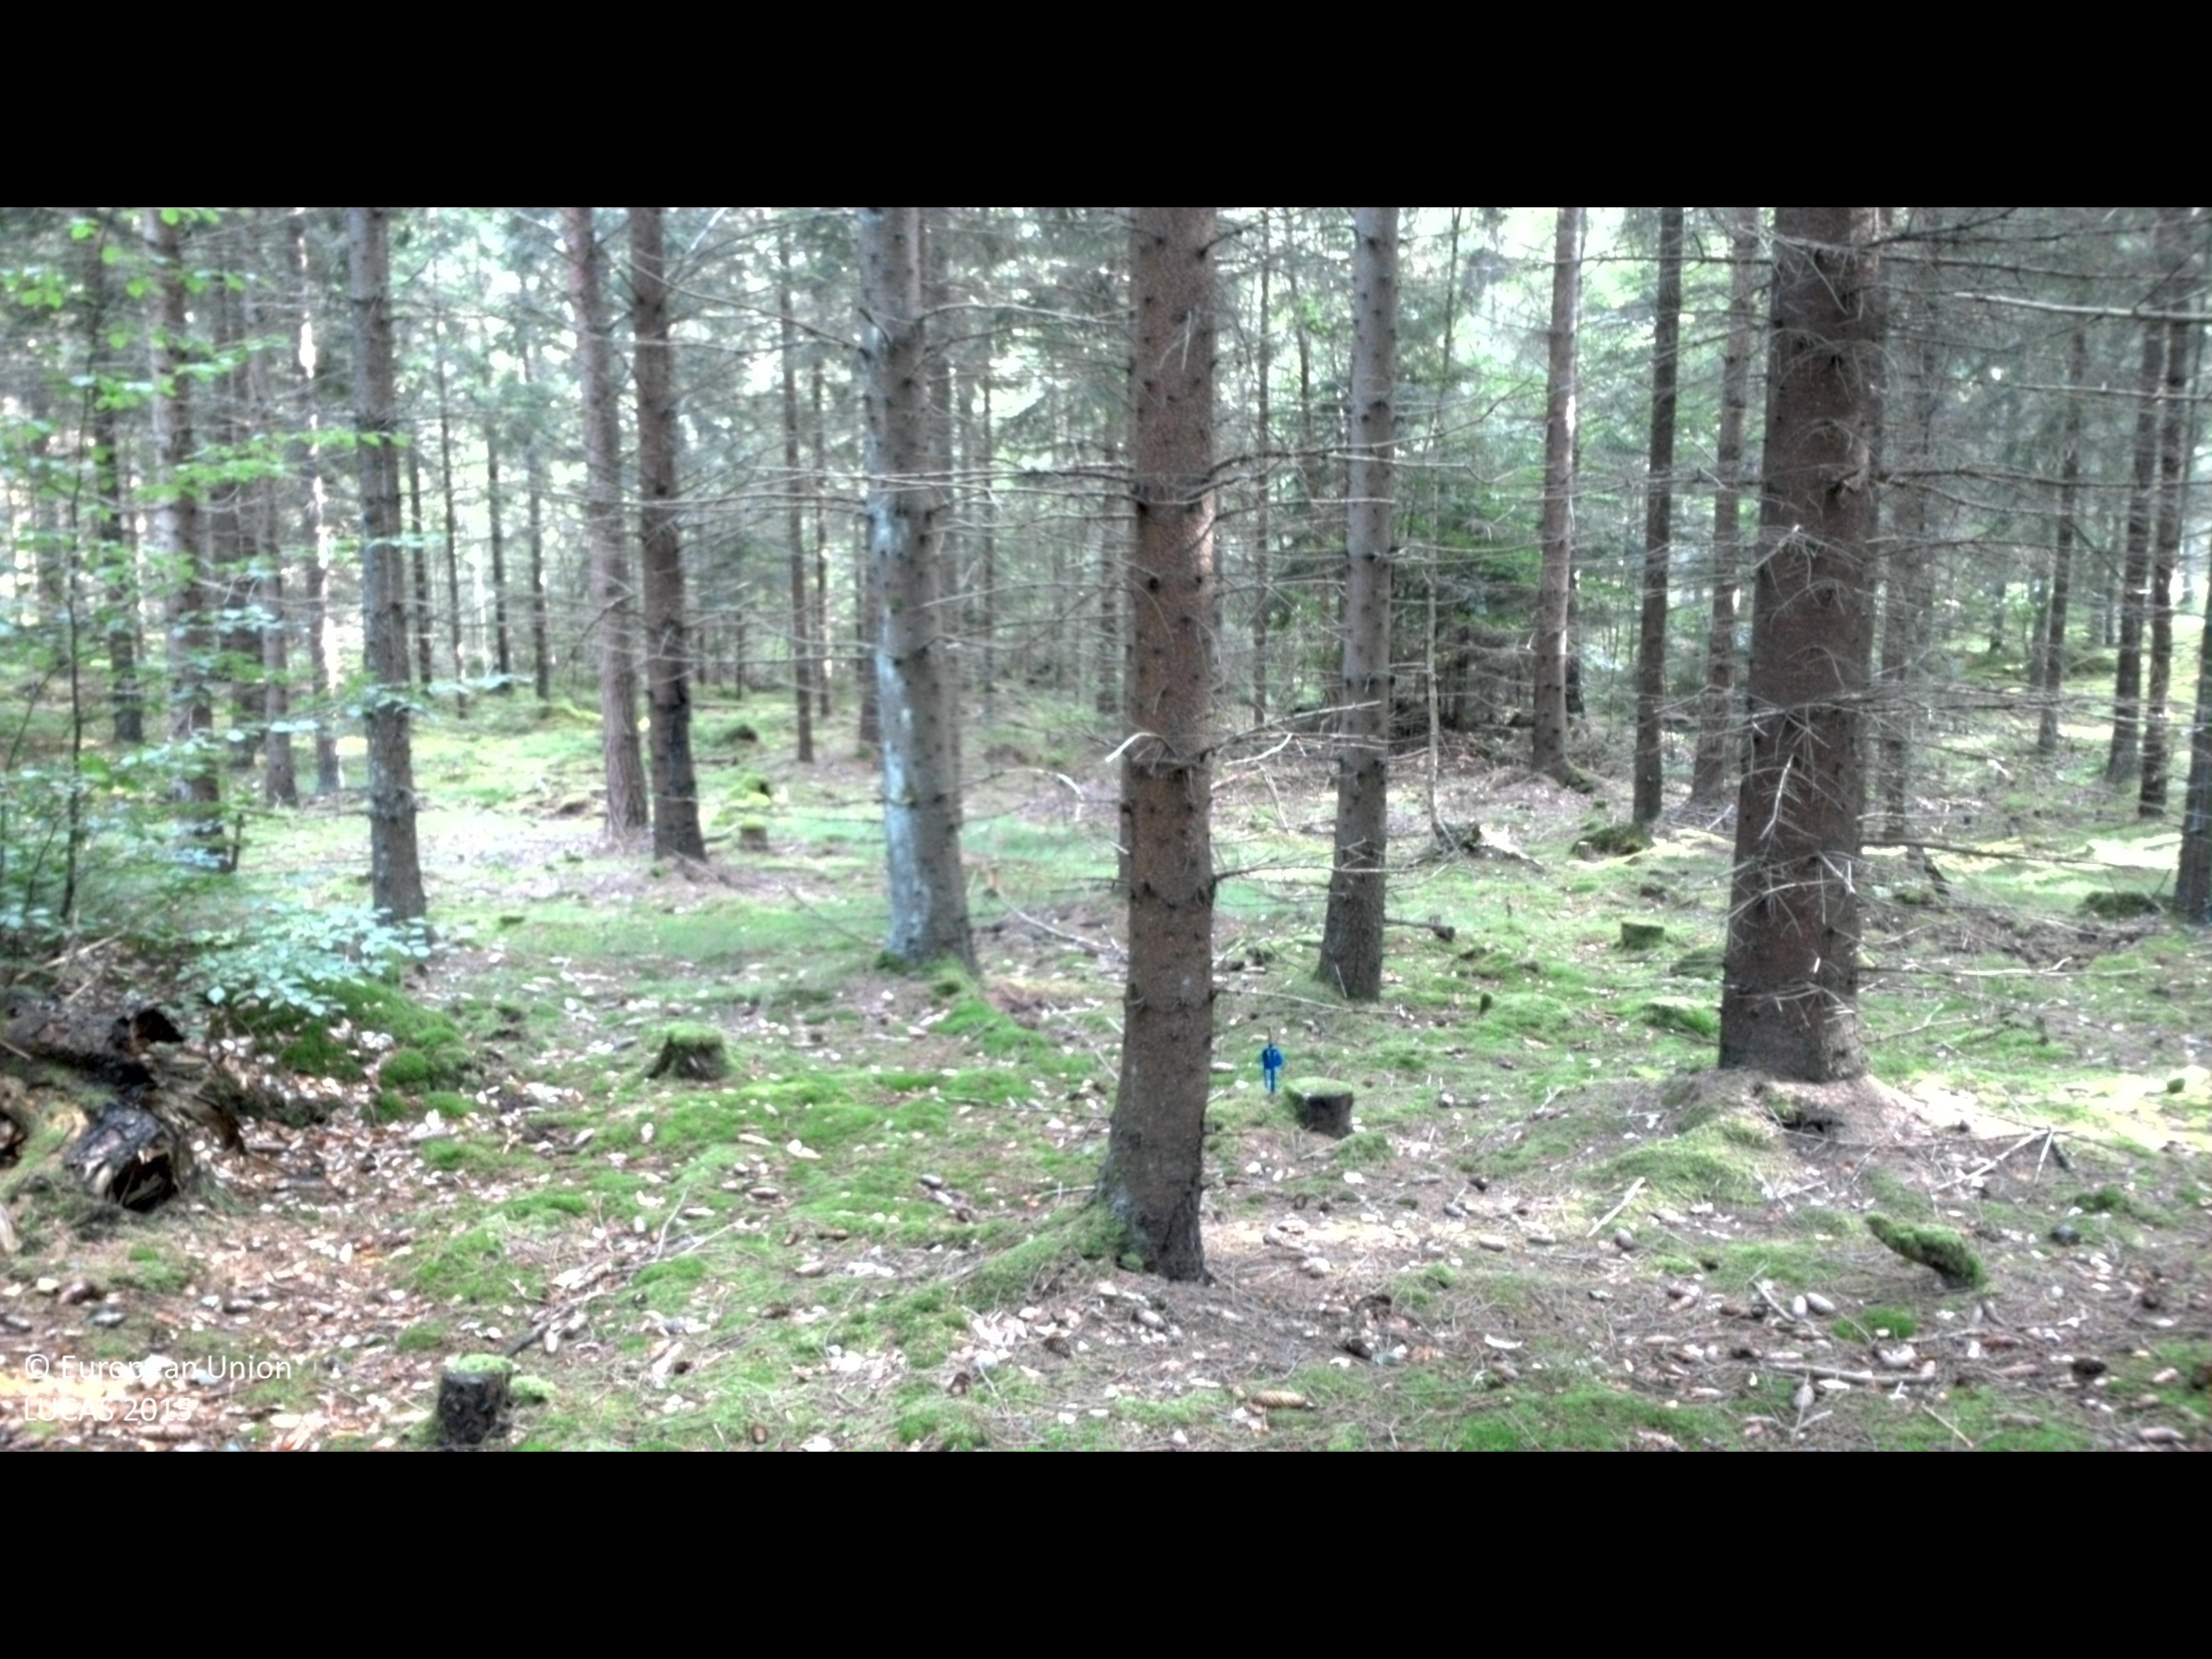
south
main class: Woodland
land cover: Spruce dominated coniferous woodland
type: boreal forest
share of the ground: 50 - 75 %
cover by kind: coniferous forest trees 65 %, lichens and mosses 25 %, broadleaved forest trees 10 %
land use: Forestry
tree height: > 5 m
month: August
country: SE
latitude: 56.2953
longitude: 15.2827
